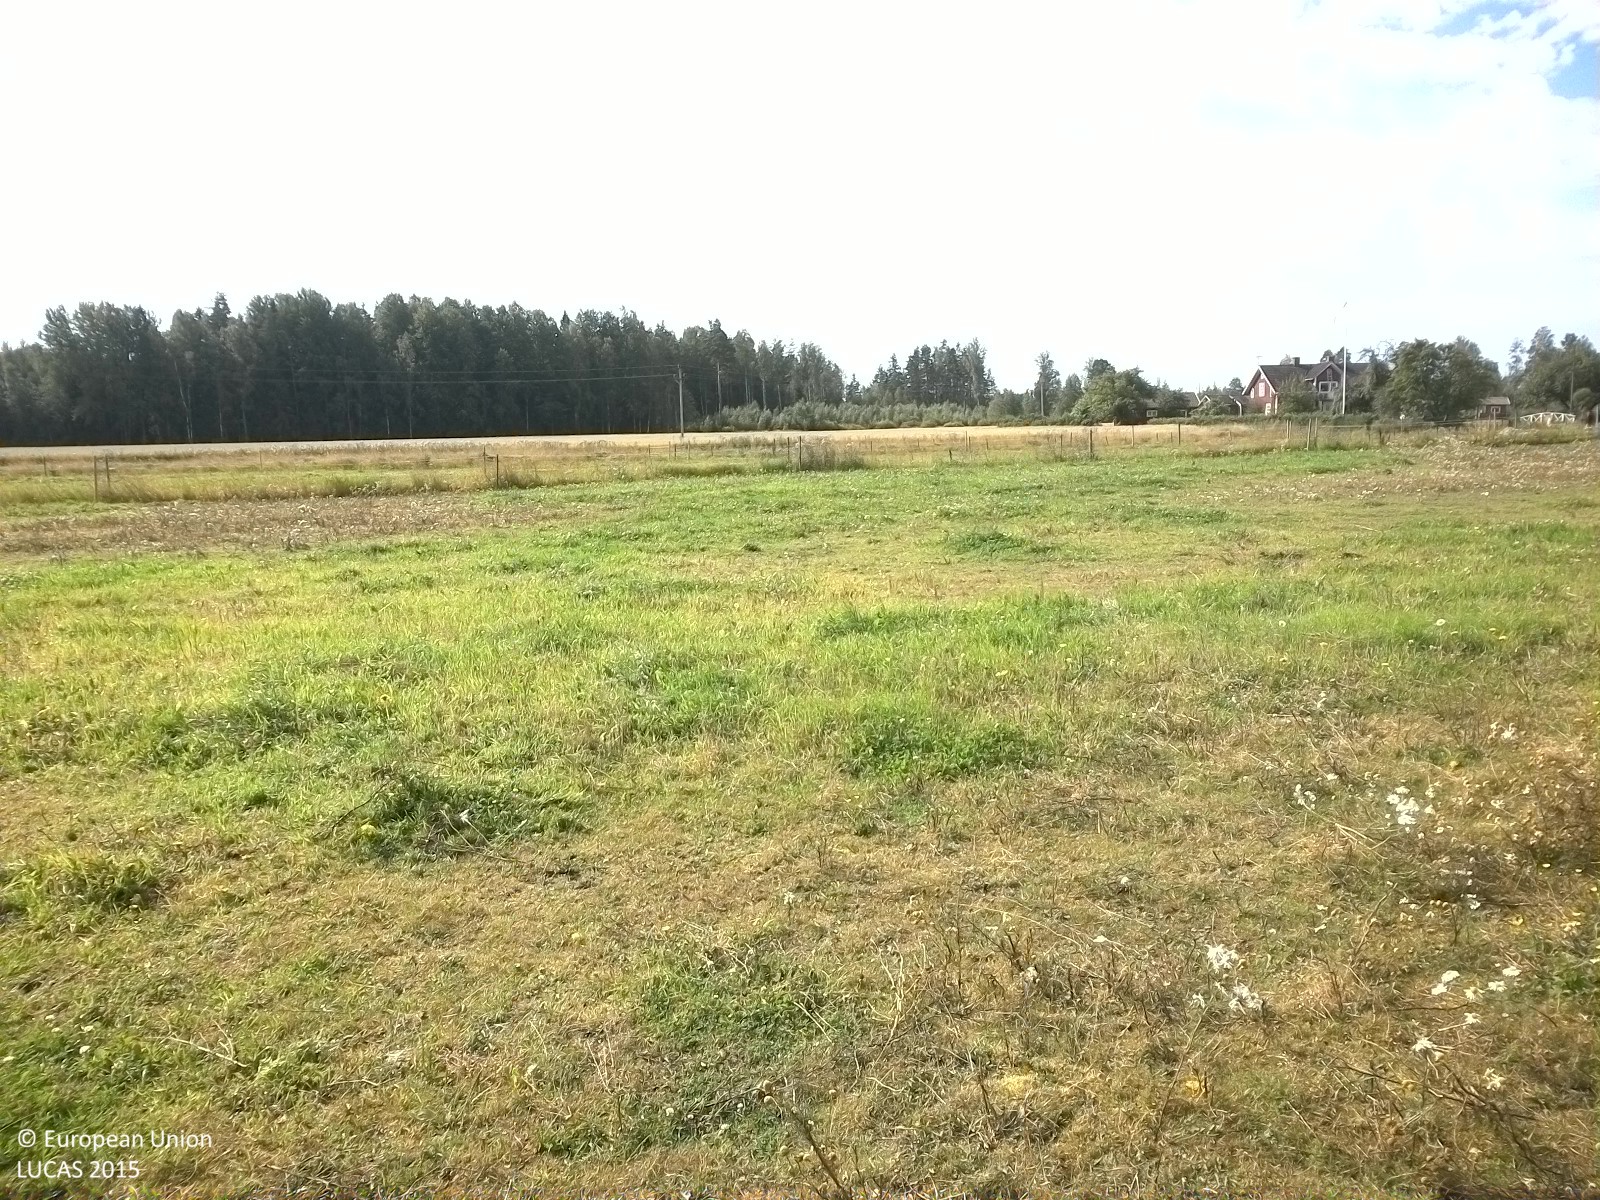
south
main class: Grassland
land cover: Grassland without tree/shrub cover
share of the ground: > 75 %
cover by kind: herbaceous plants 100 %
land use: Agriculture (excluding fallow land and kitchen gardens)
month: August
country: SE
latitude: 59.0975
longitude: 15.0720
